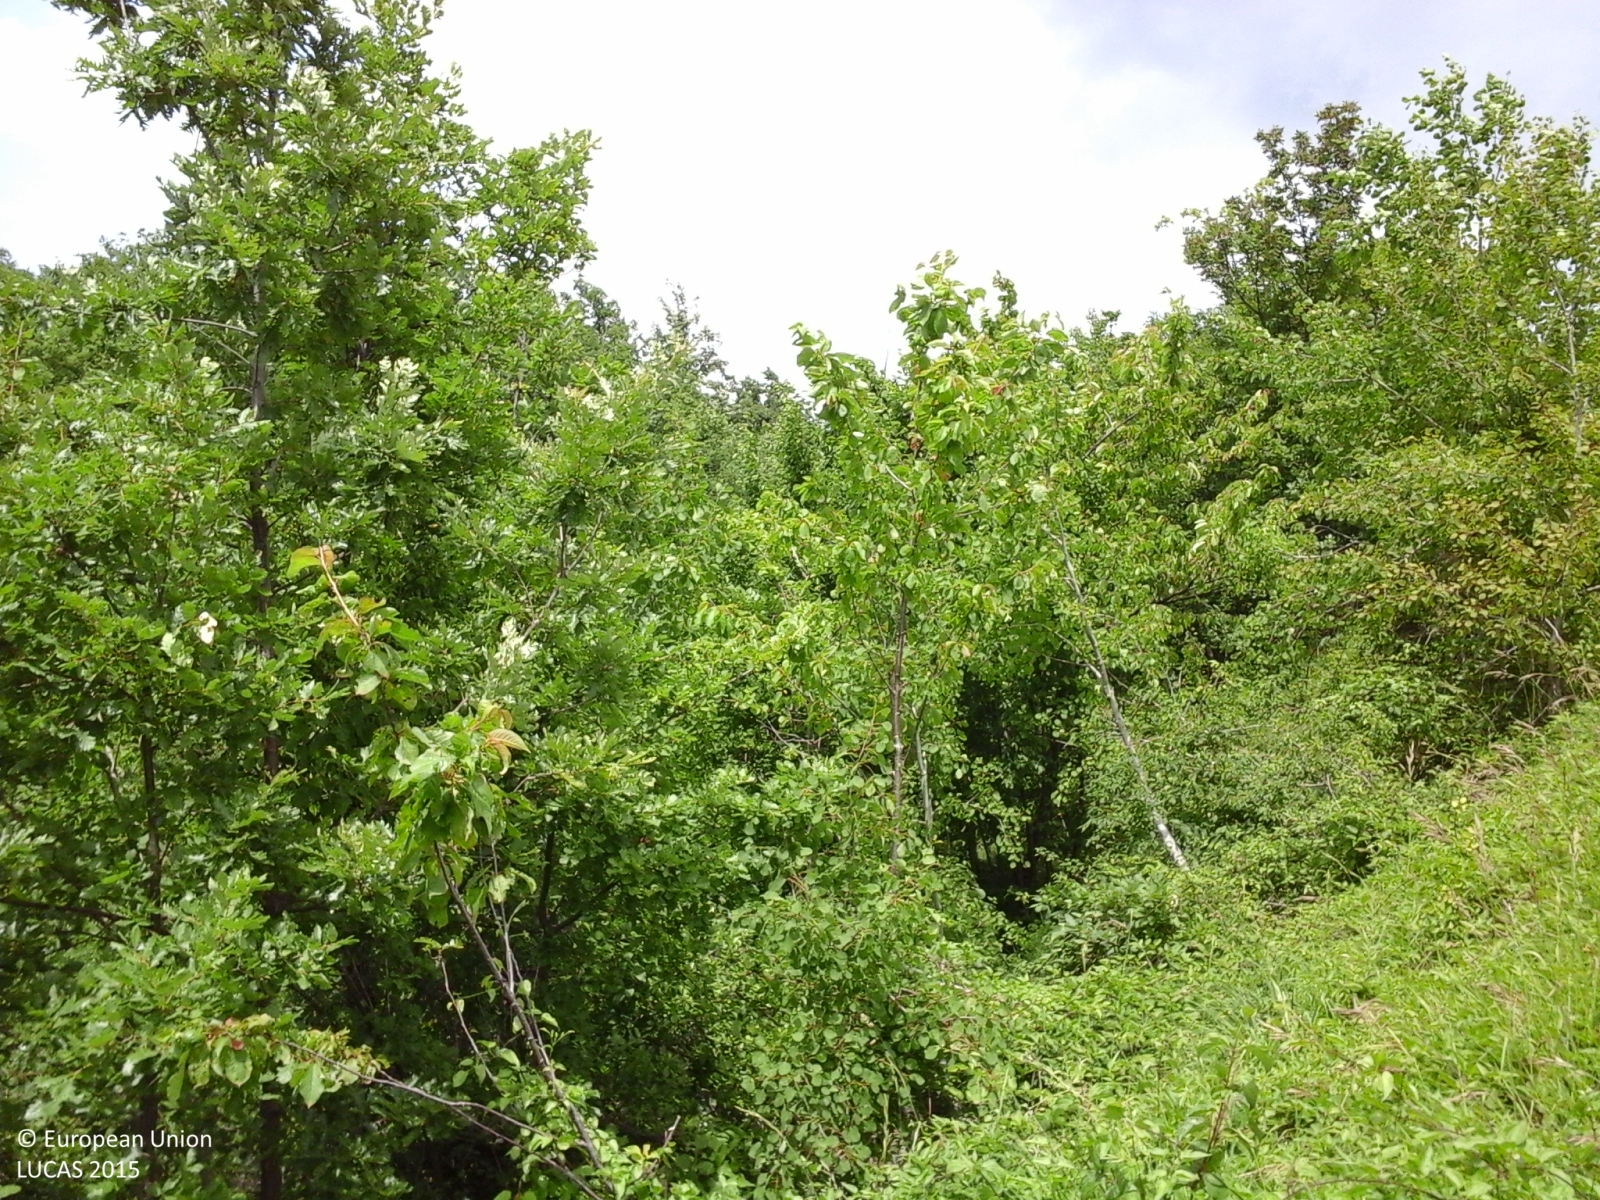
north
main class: Woodland
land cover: Broadleaved woodland
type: thermophilous deciduous forest
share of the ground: > 75 %
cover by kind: broadleaved forest trees 100 %
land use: Forestry
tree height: > 5 m
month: June
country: IT
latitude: 44.6926
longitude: 9.6348
